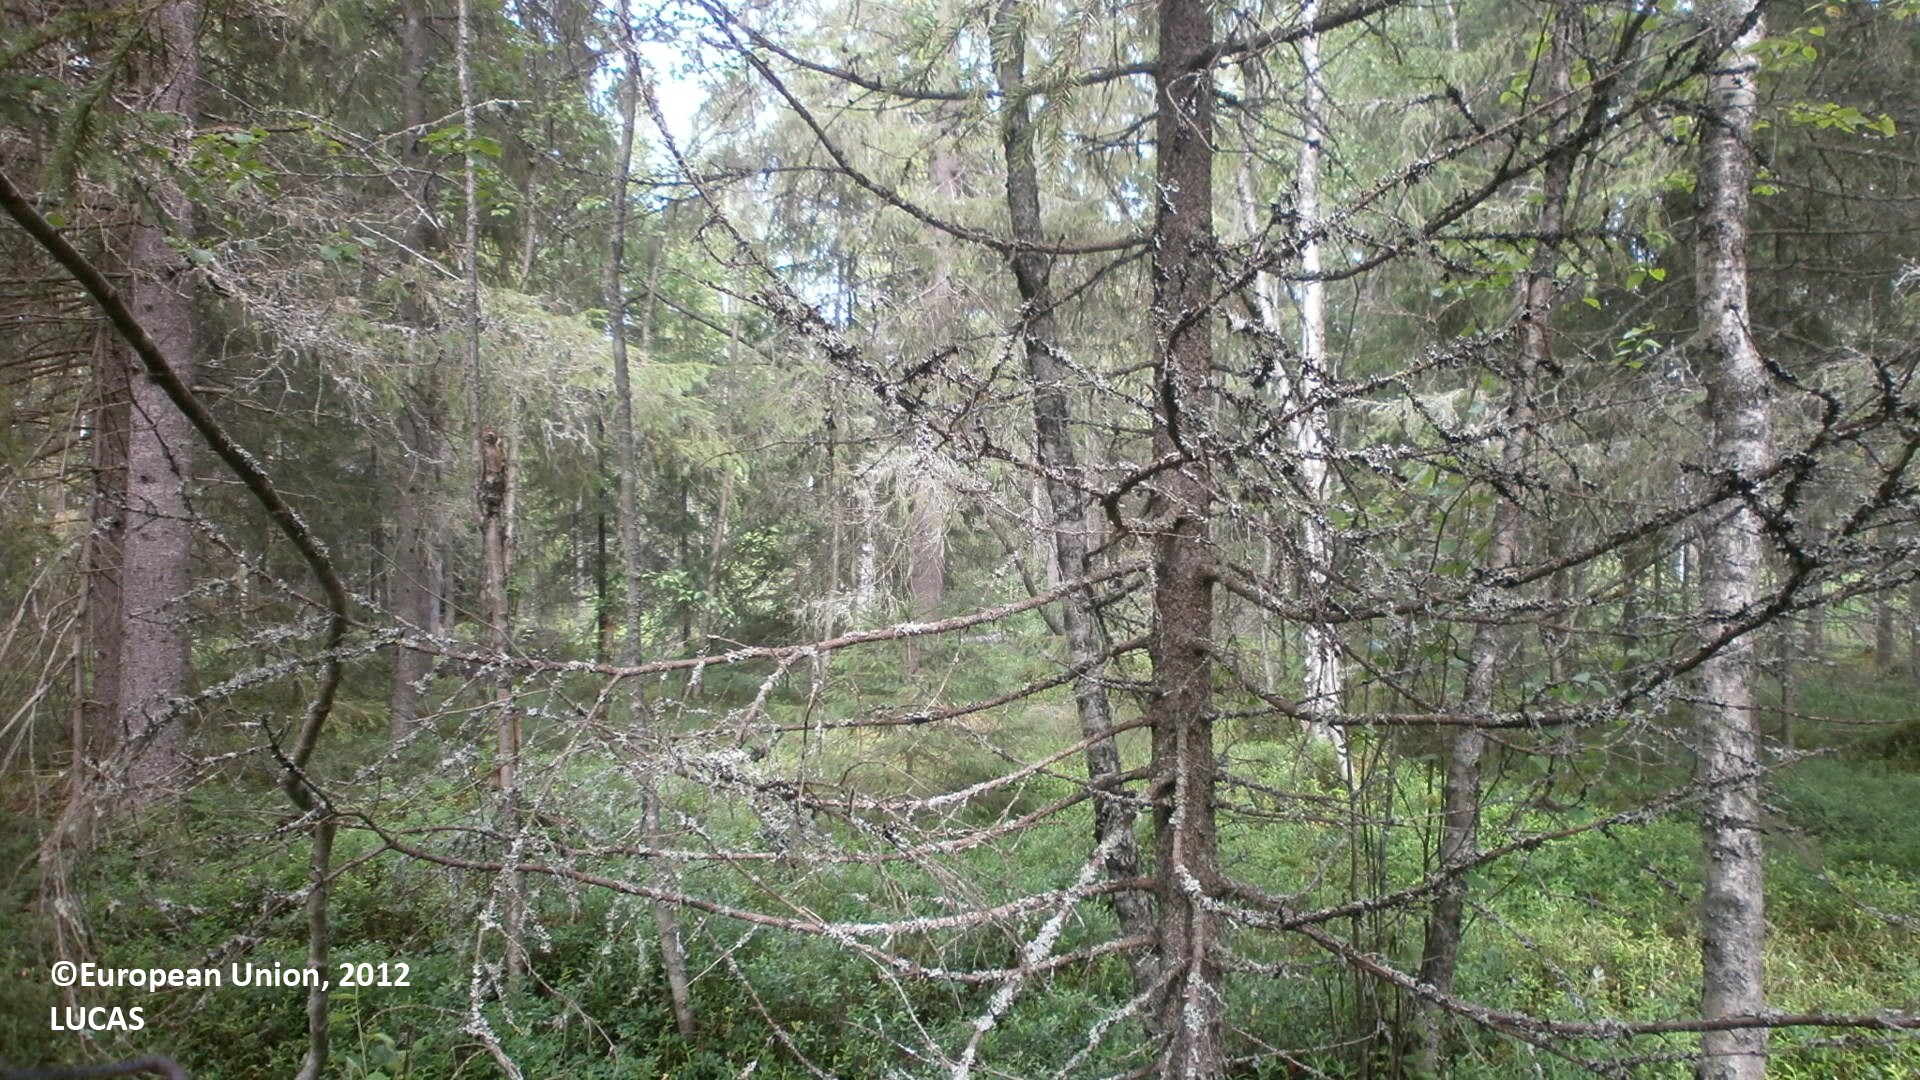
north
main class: Woodland
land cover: Spruce dominated mixed woodland
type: boreal forest
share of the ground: > 75 %
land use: Forestry
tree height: > 5 m
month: July
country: FI
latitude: 64.5305
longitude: 24.3849
